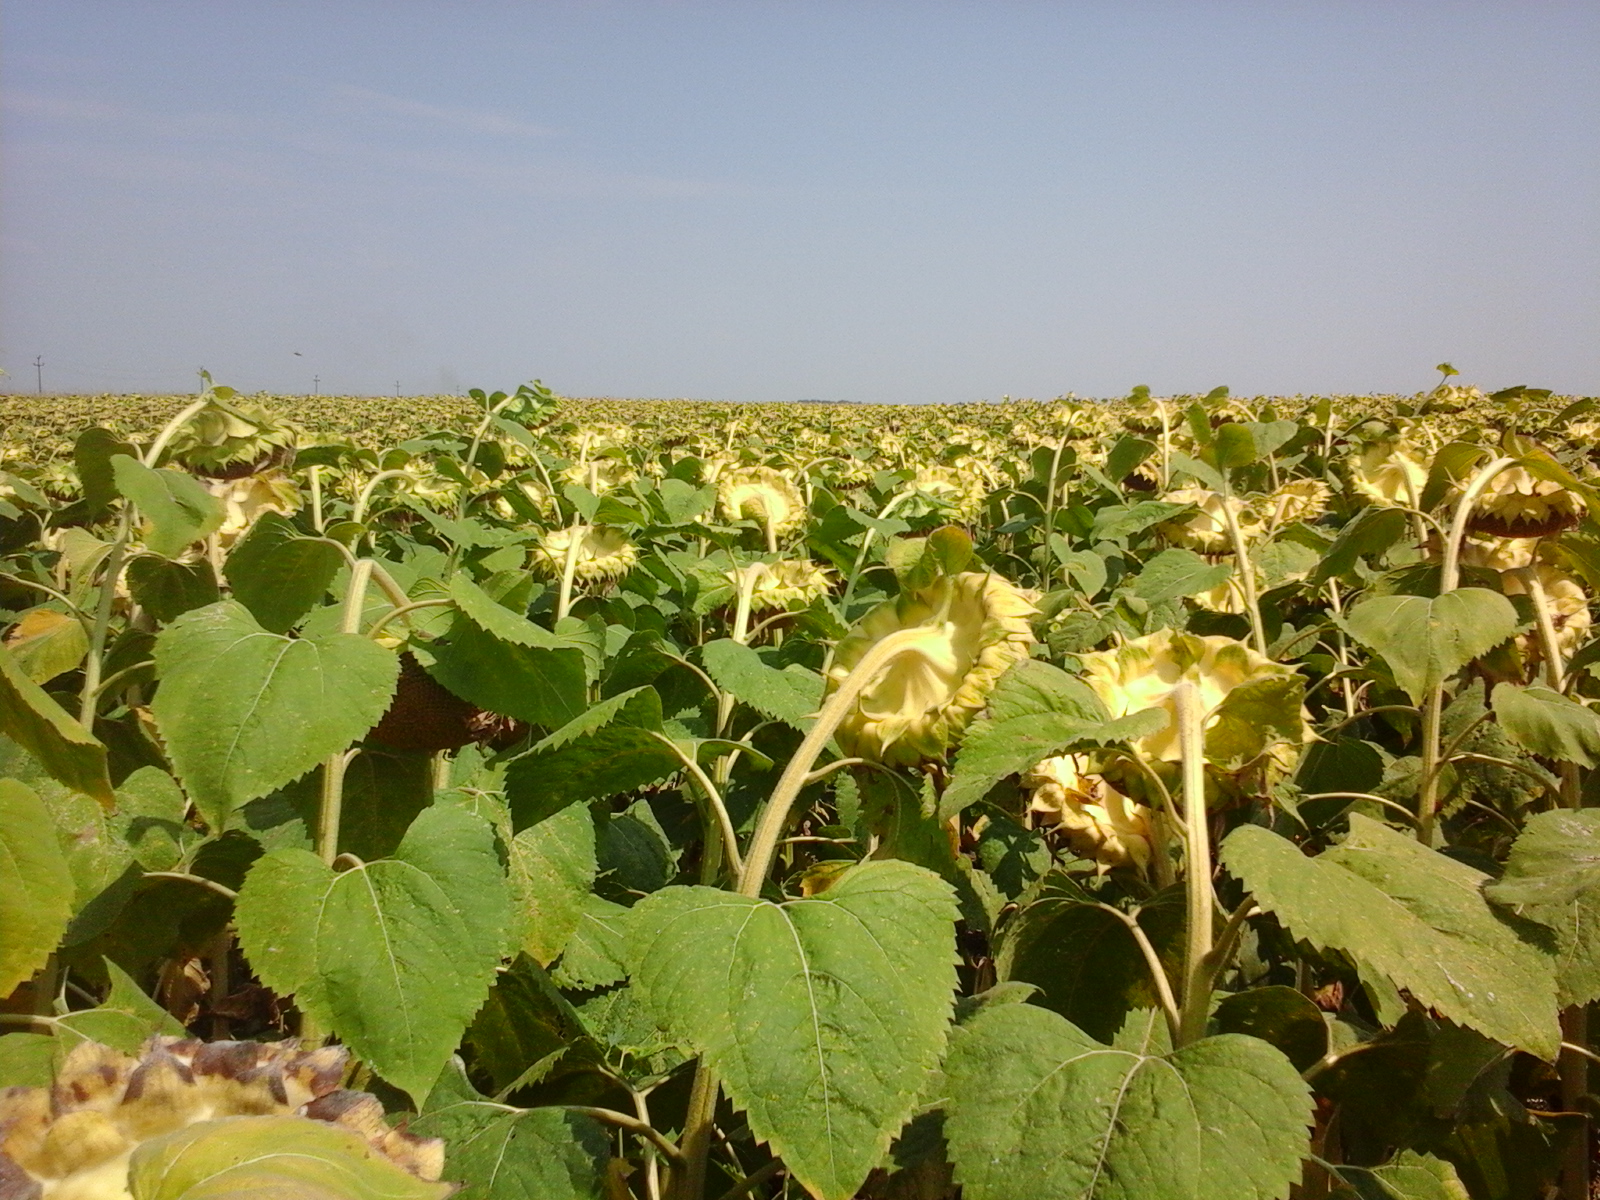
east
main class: Cropland
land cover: Sunflower
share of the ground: > 75 %
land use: Agriculture (excluding fallow land and kitchen gardens)
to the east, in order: Sunflower; Maize
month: August
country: RO
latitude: 43.8994
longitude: 23.6585
